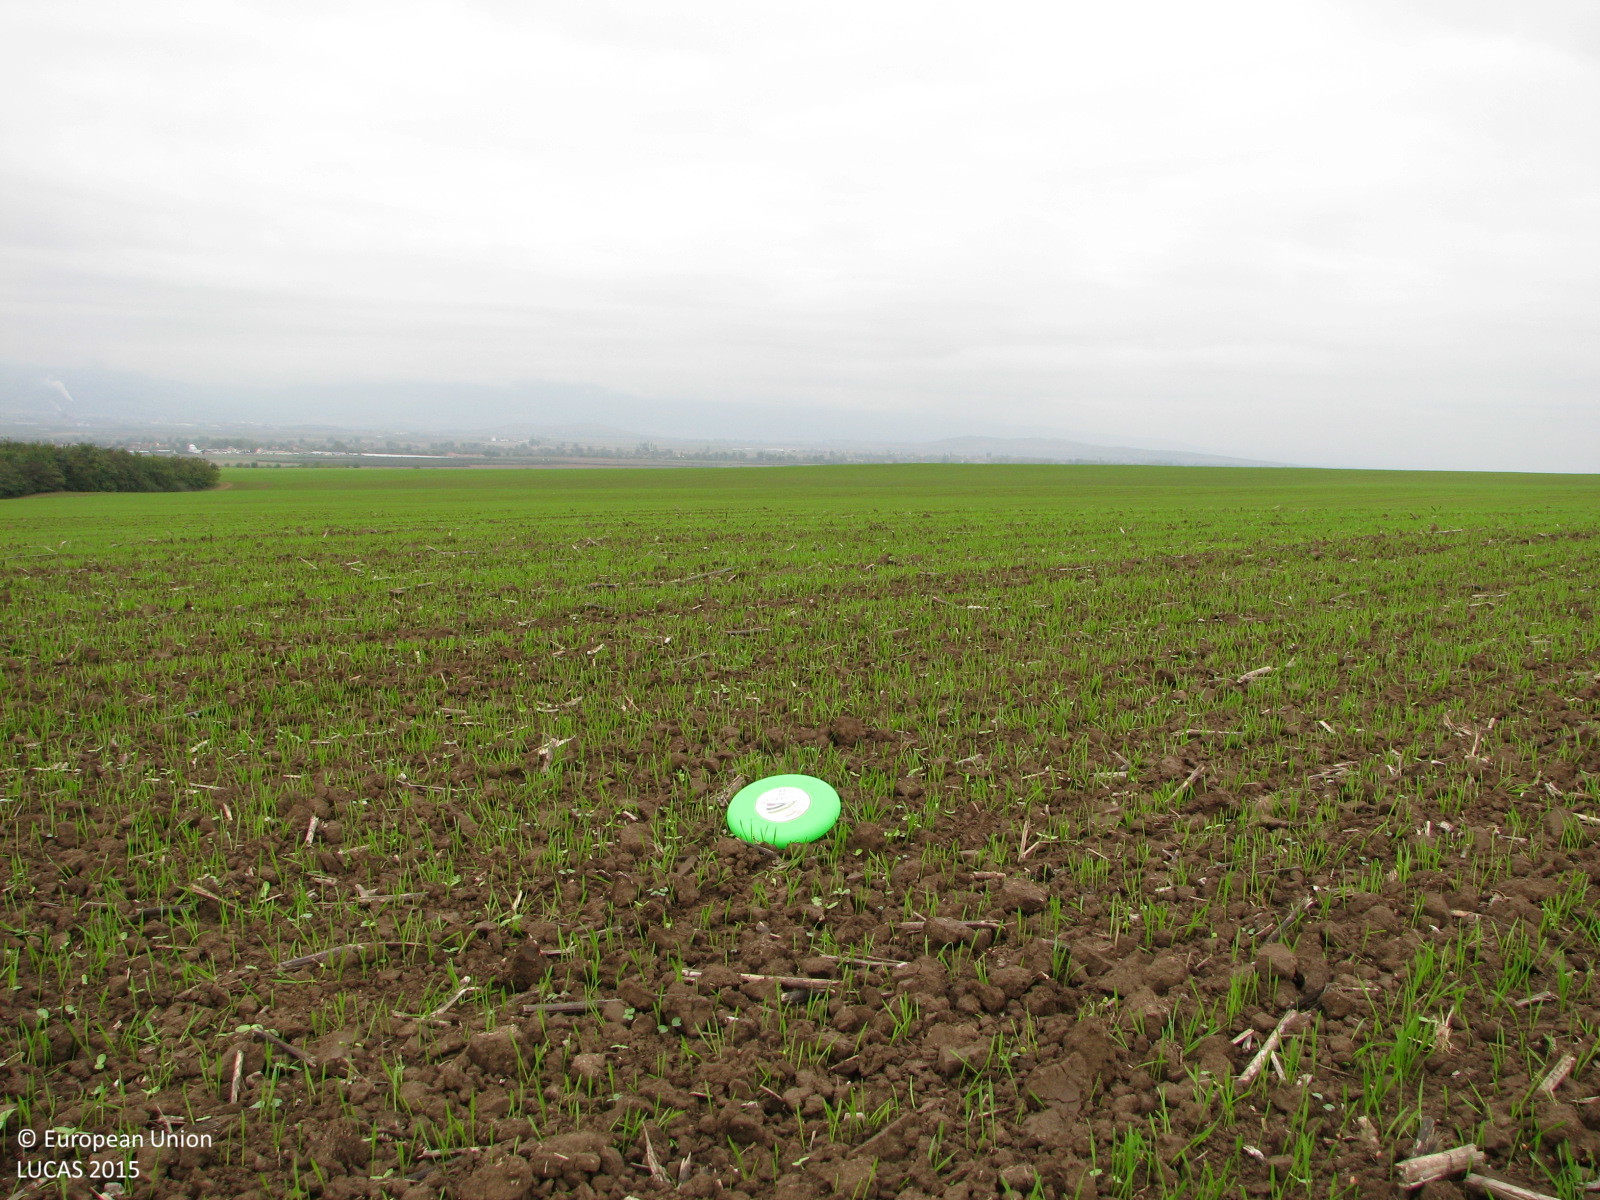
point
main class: Cropland
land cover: Common wheat
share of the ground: > 75 %
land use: Agriculture (excluding fallow land and kitchen gardens)
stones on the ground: < 10 %
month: October
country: BG
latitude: 42.5630
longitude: 26.2511
